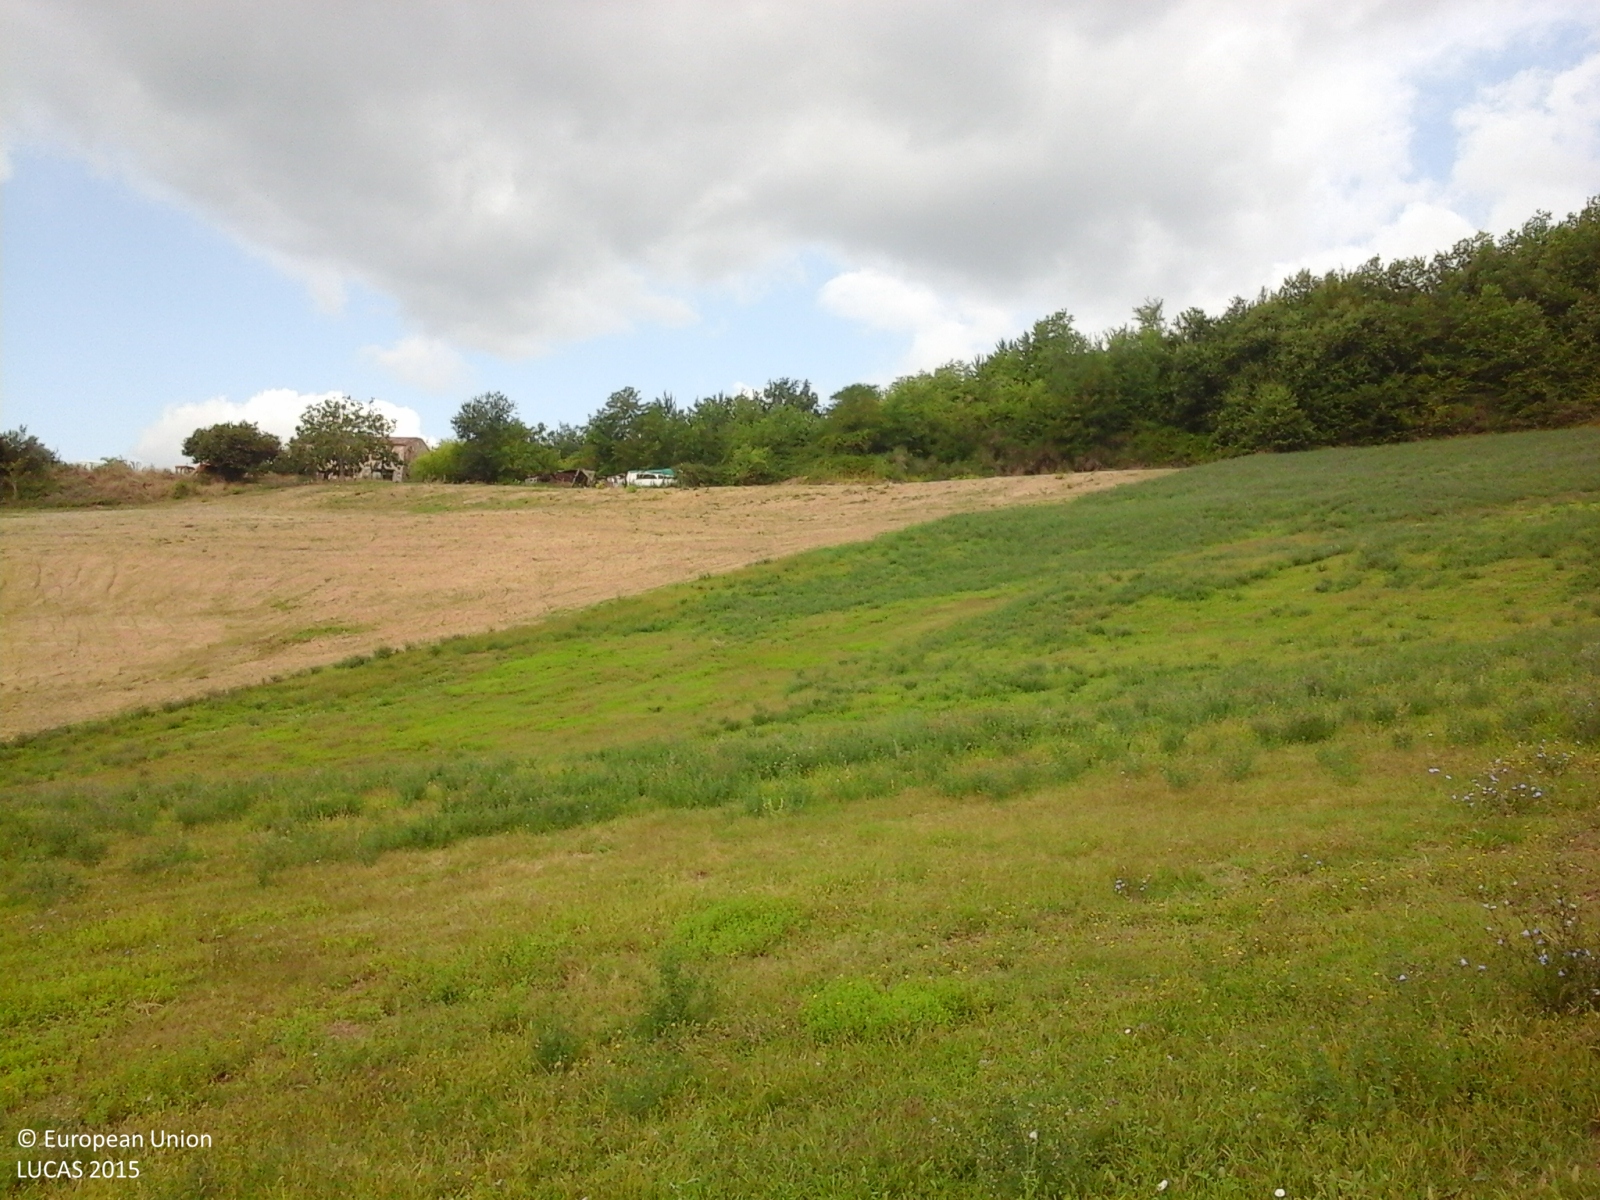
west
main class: Cropland
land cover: Durum wheat
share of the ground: < 10 %
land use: Agriculture (excluding fallow land and kitchen gardens)
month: August
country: IT
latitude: 43.3086
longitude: 13.1848
